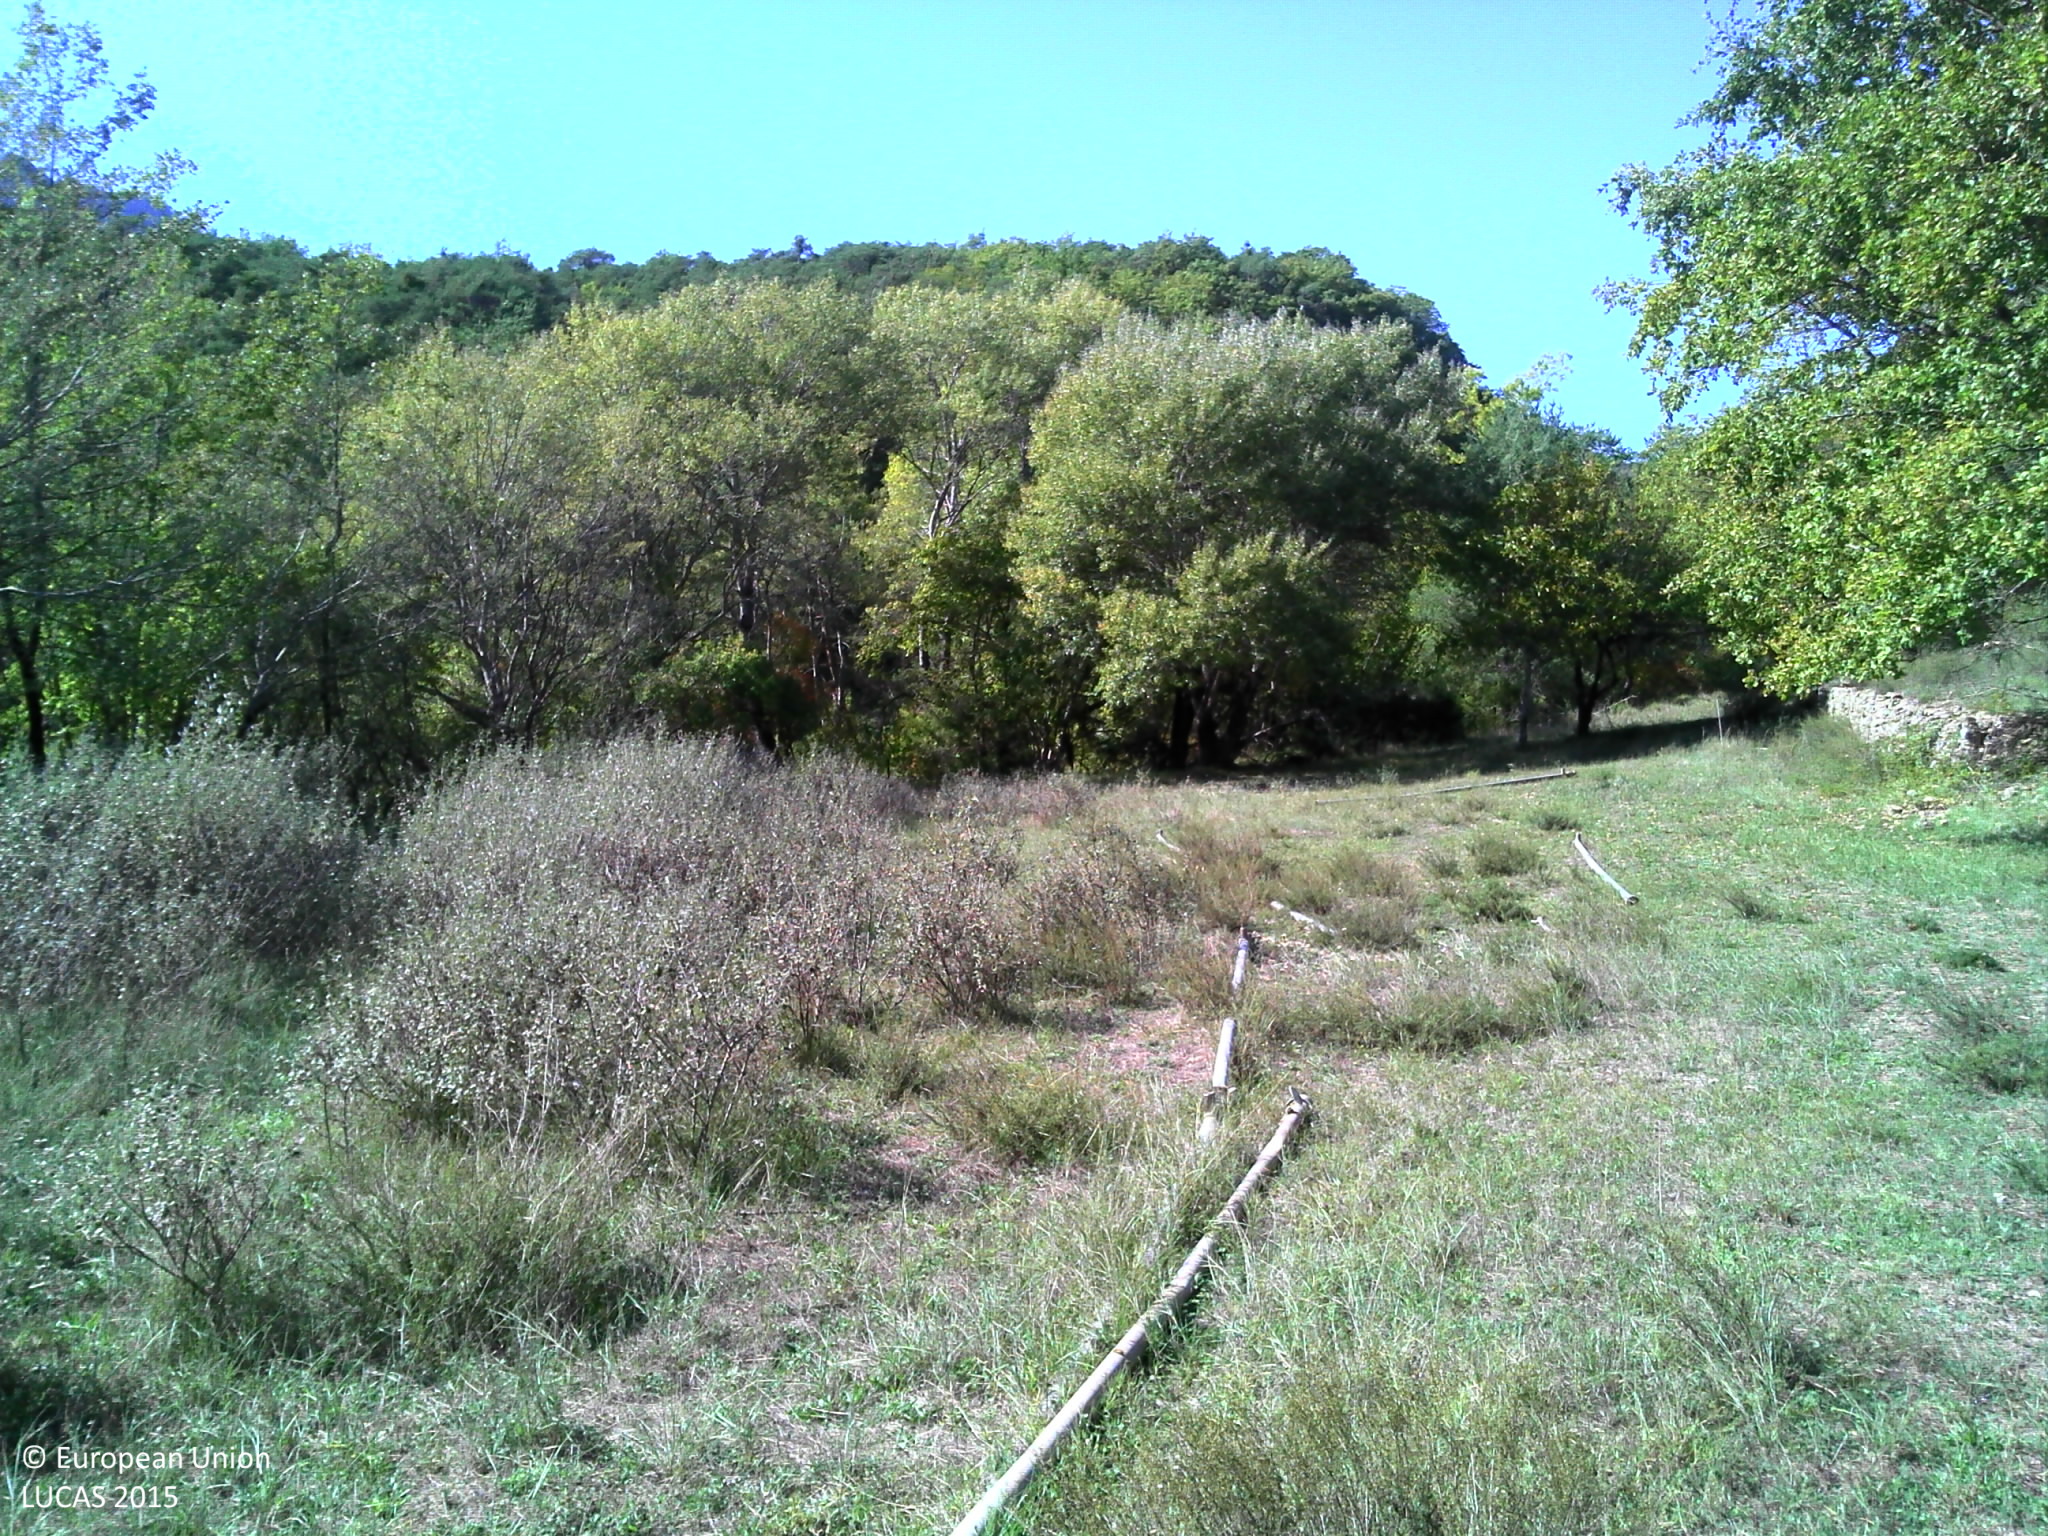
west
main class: Grassland
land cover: Grassland without tree/shrub cover
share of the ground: > 75 %
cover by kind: herbaceous plants 95 %, shrubs 5 %
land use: Agriculture (excluding fallow land and kitchen gardens)
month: September
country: FR
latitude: 43.8569
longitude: 7.0335
